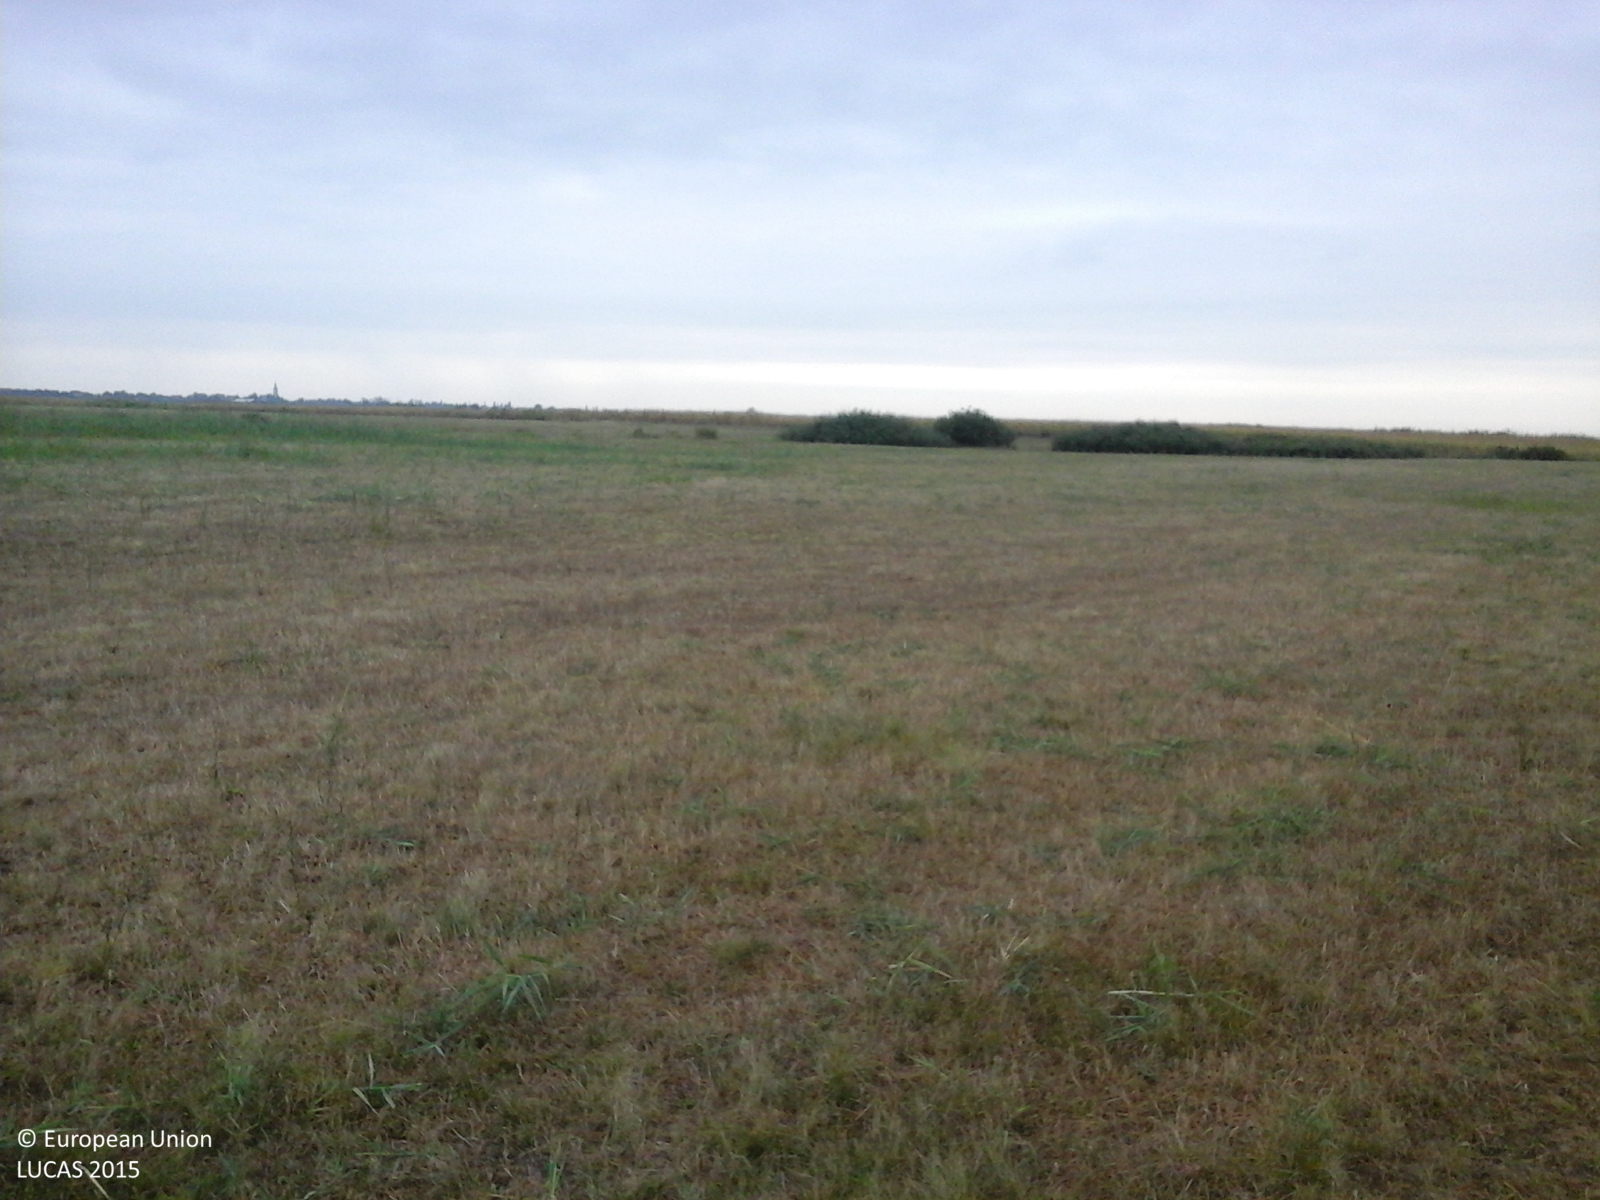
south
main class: Grassland
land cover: Grassland without tree/shrub cover
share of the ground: > 75 %
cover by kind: herbaceous plants 100 %
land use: Agriculture (excluding fallow land and kitchen gardens)
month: August
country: RO
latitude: 45.6727
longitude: 21.0032
